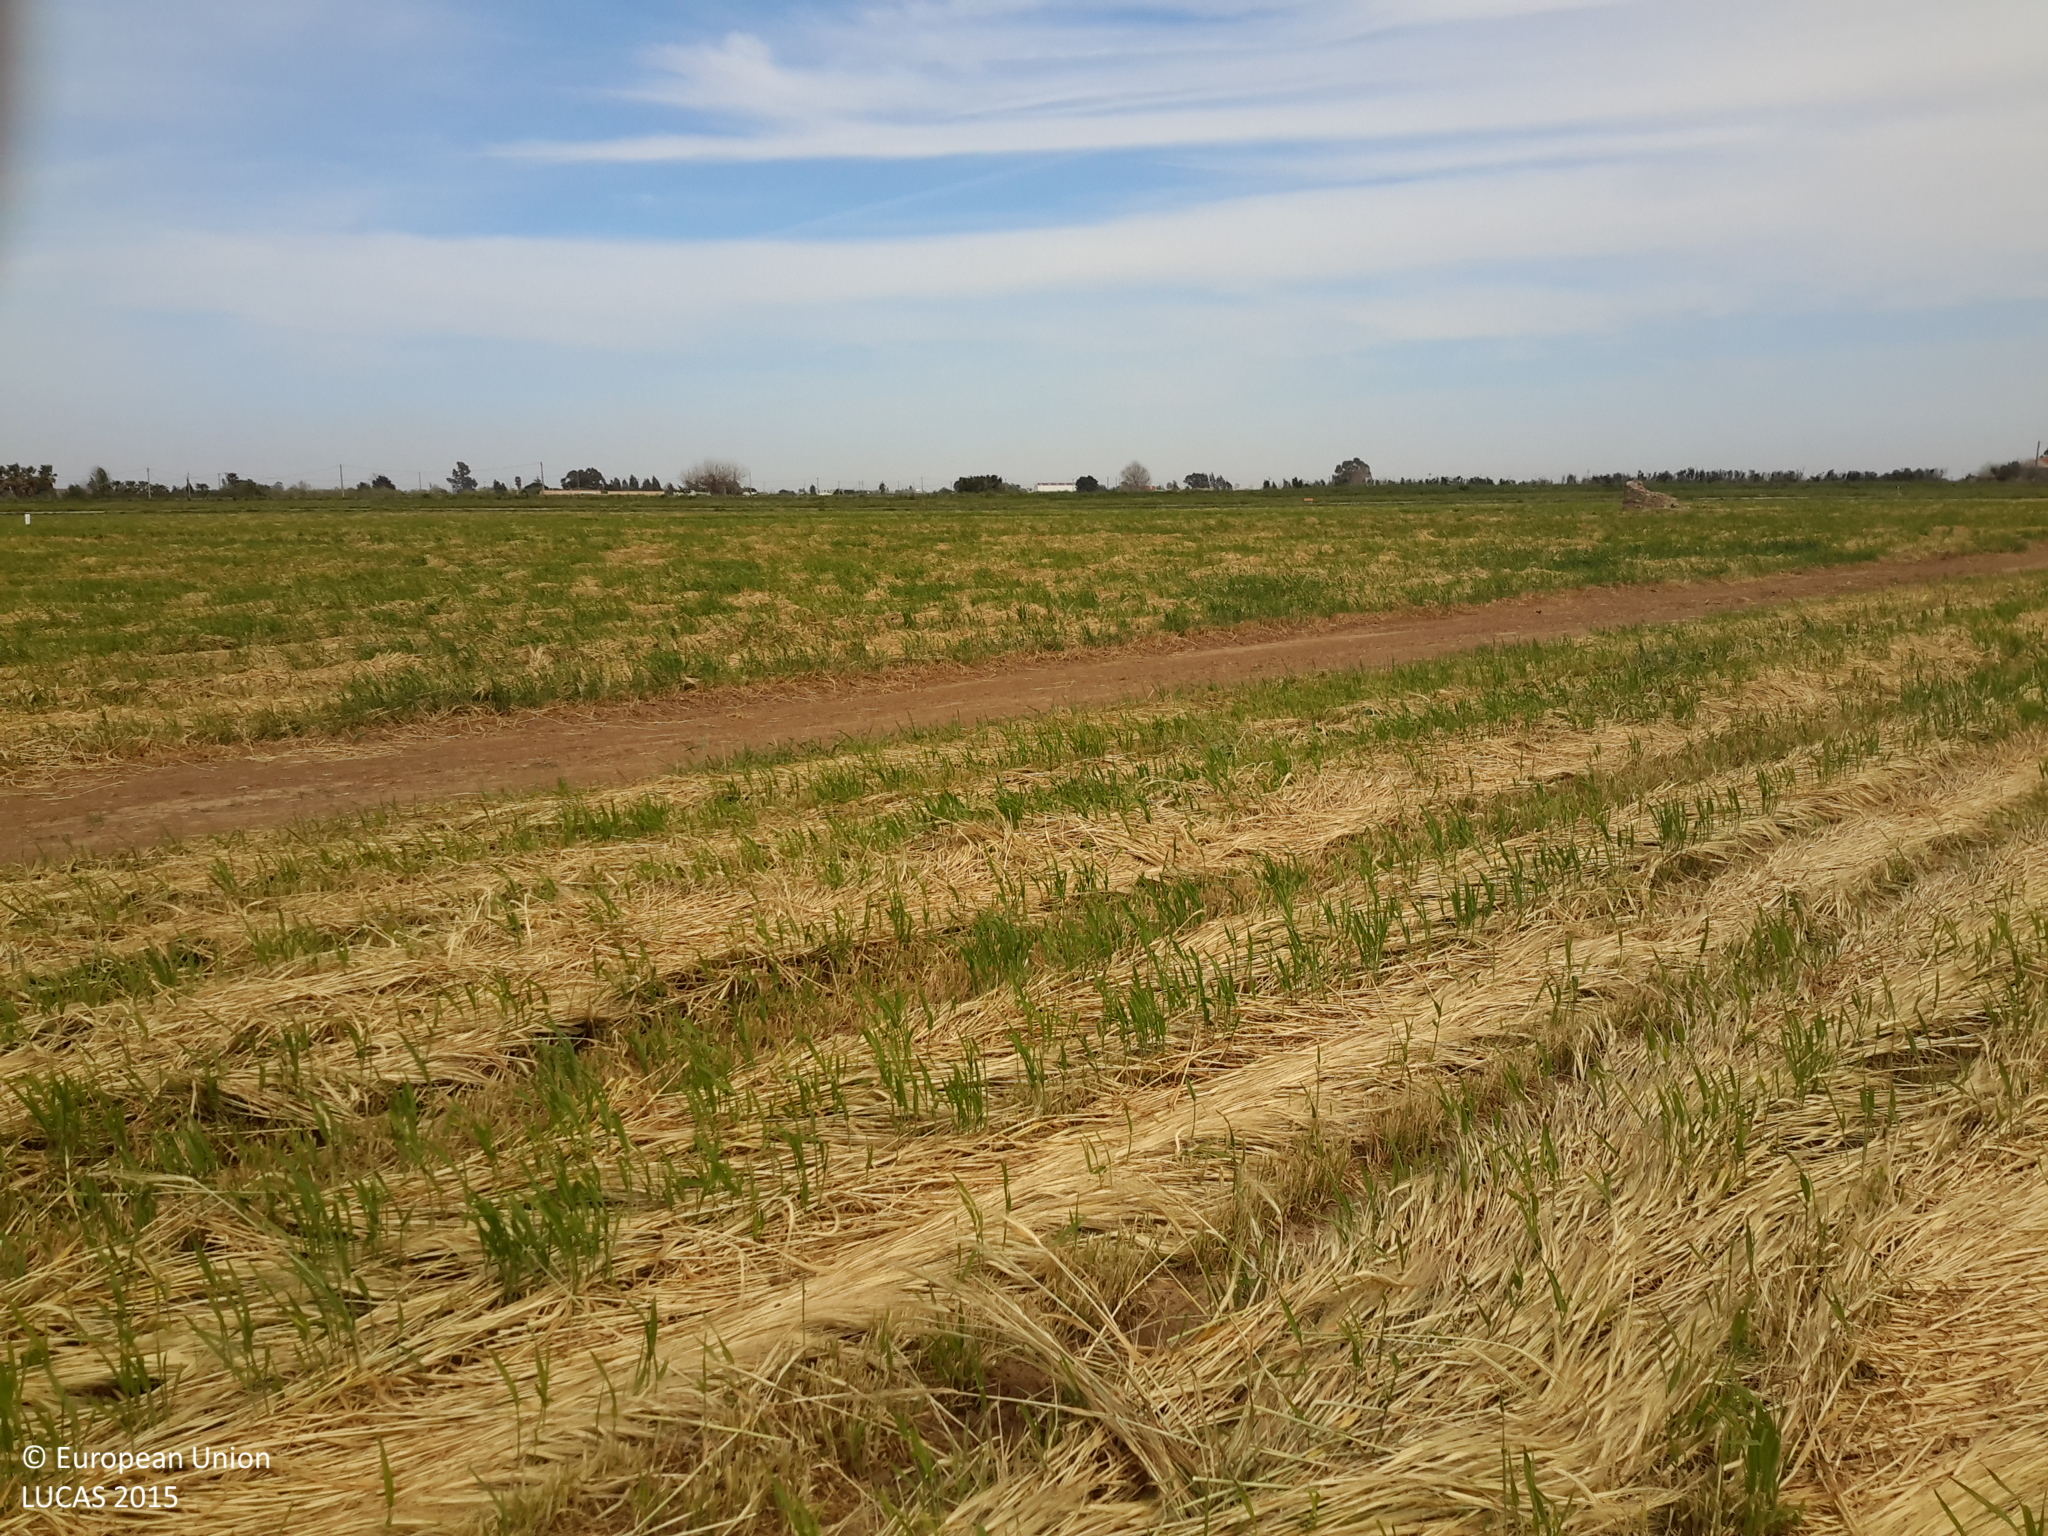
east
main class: Cropland
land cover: Common wheat
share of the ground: > 75 %
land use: Agriculture (excluding fallow land and kitchen gardens)
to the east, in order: Other structural elements; Common wheat; Tracks; Ditches and canals; Grassland without tree/shrub cover; Tracks; Grassland without tree/shrub cover; Tracks; Grassland without tree/shrub cover; Ditches and canals; Grass margins; Paved roads, cycling and walking lanes; Grass margins; Paved roads, cycling and walking lanes; Rice
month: April
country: ES
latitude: 40.6876
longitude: 0.5881
